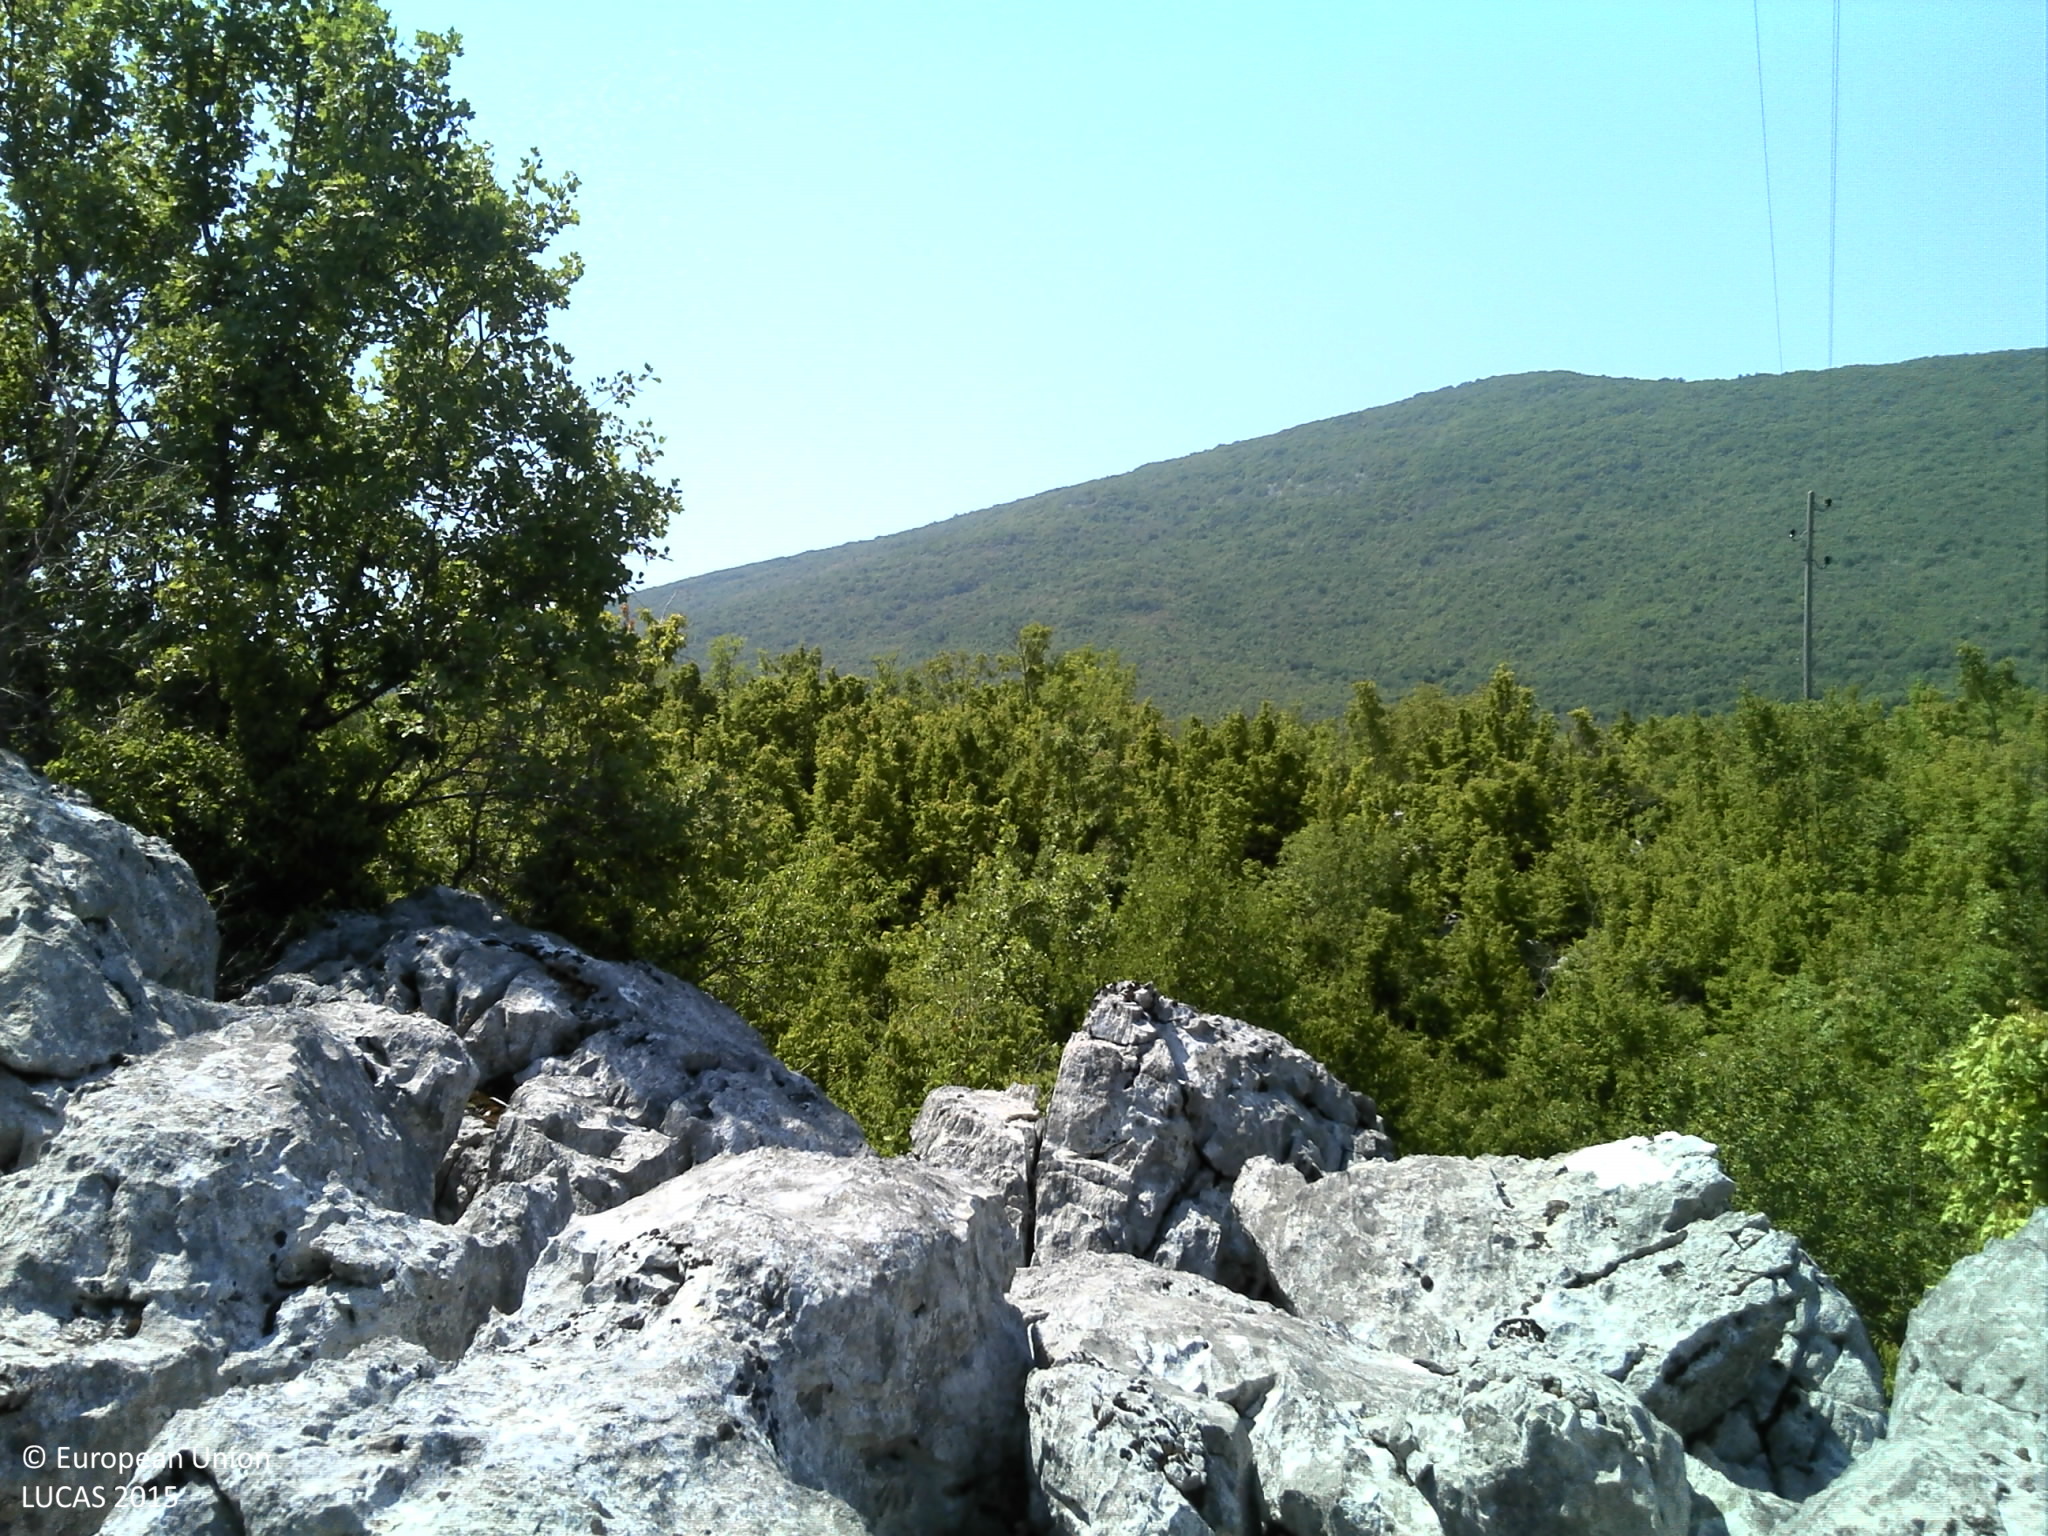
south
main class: Shrubland
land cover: Shrubland with sparse tree cover
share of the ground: > 75 %
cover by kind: shrubs 75 %, consolidated bare surface 10 %, broadleaved forest trees 5 %, herbaceous plants 5 %, unconsolidated bare surface 5 %
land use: Semi-natural and natural areas not in use
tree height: > 5 m
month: July
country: HR
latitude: 43.4624
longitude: 16.9995
